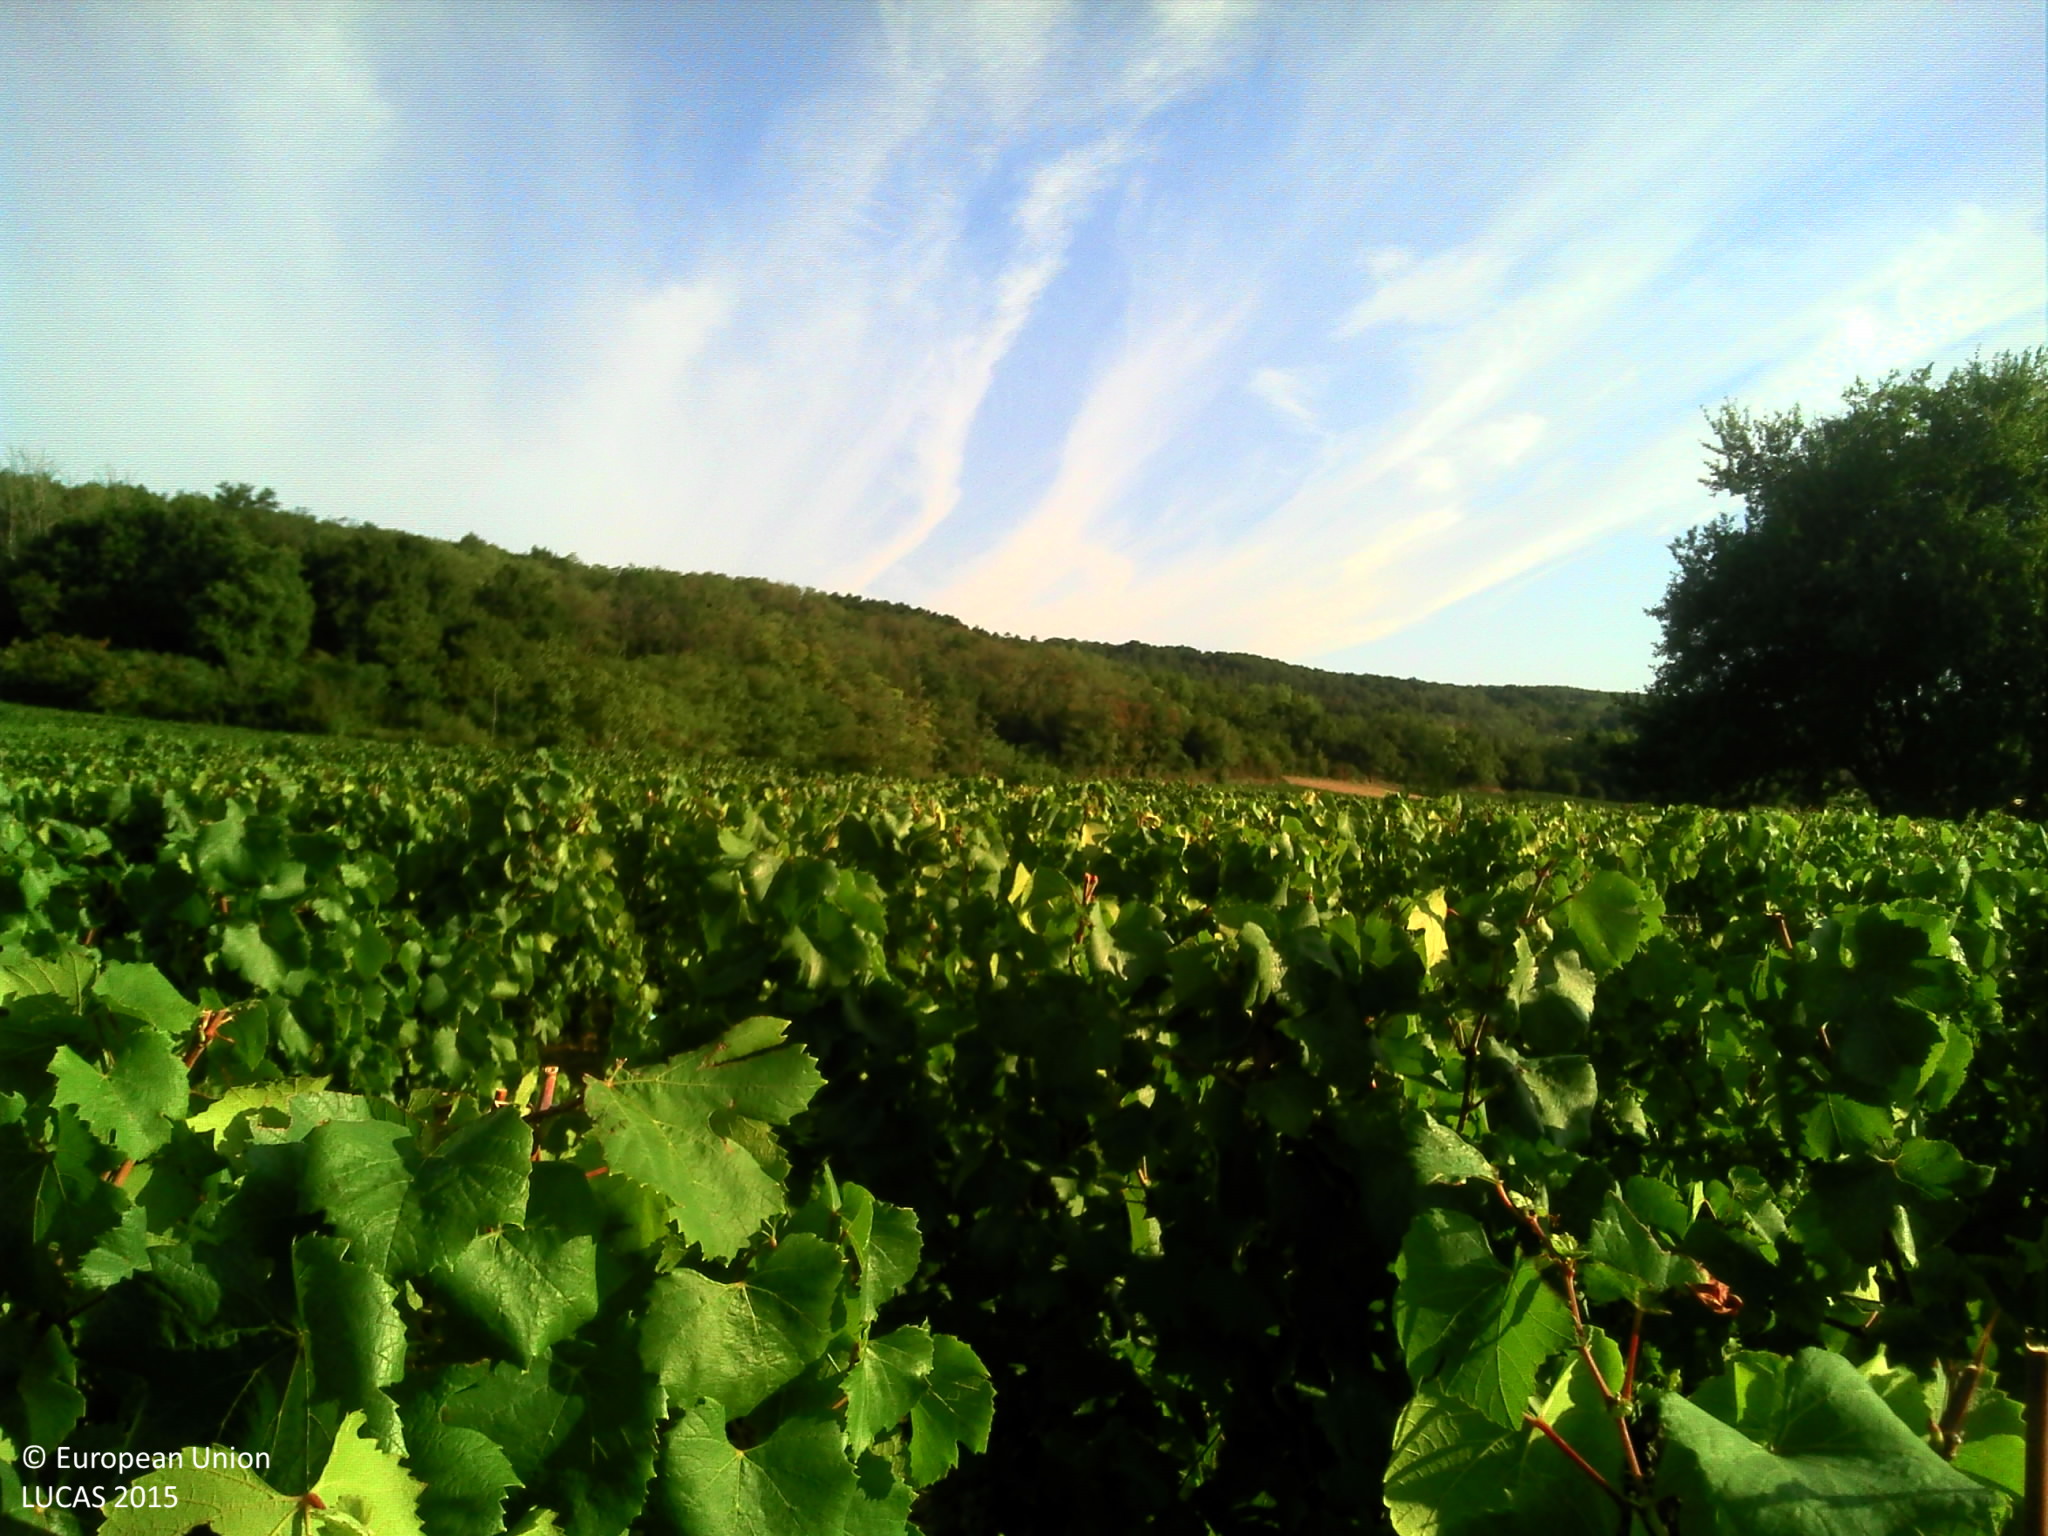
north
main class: Cropland
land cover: Vineyards
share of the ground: 50 - 75 %
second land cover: Other bare soil
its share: > 75 %
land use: Agriculture (excluding fallow land and kitchen gardens)
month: August
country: FR
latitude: 46.4430
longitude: 4.8344
